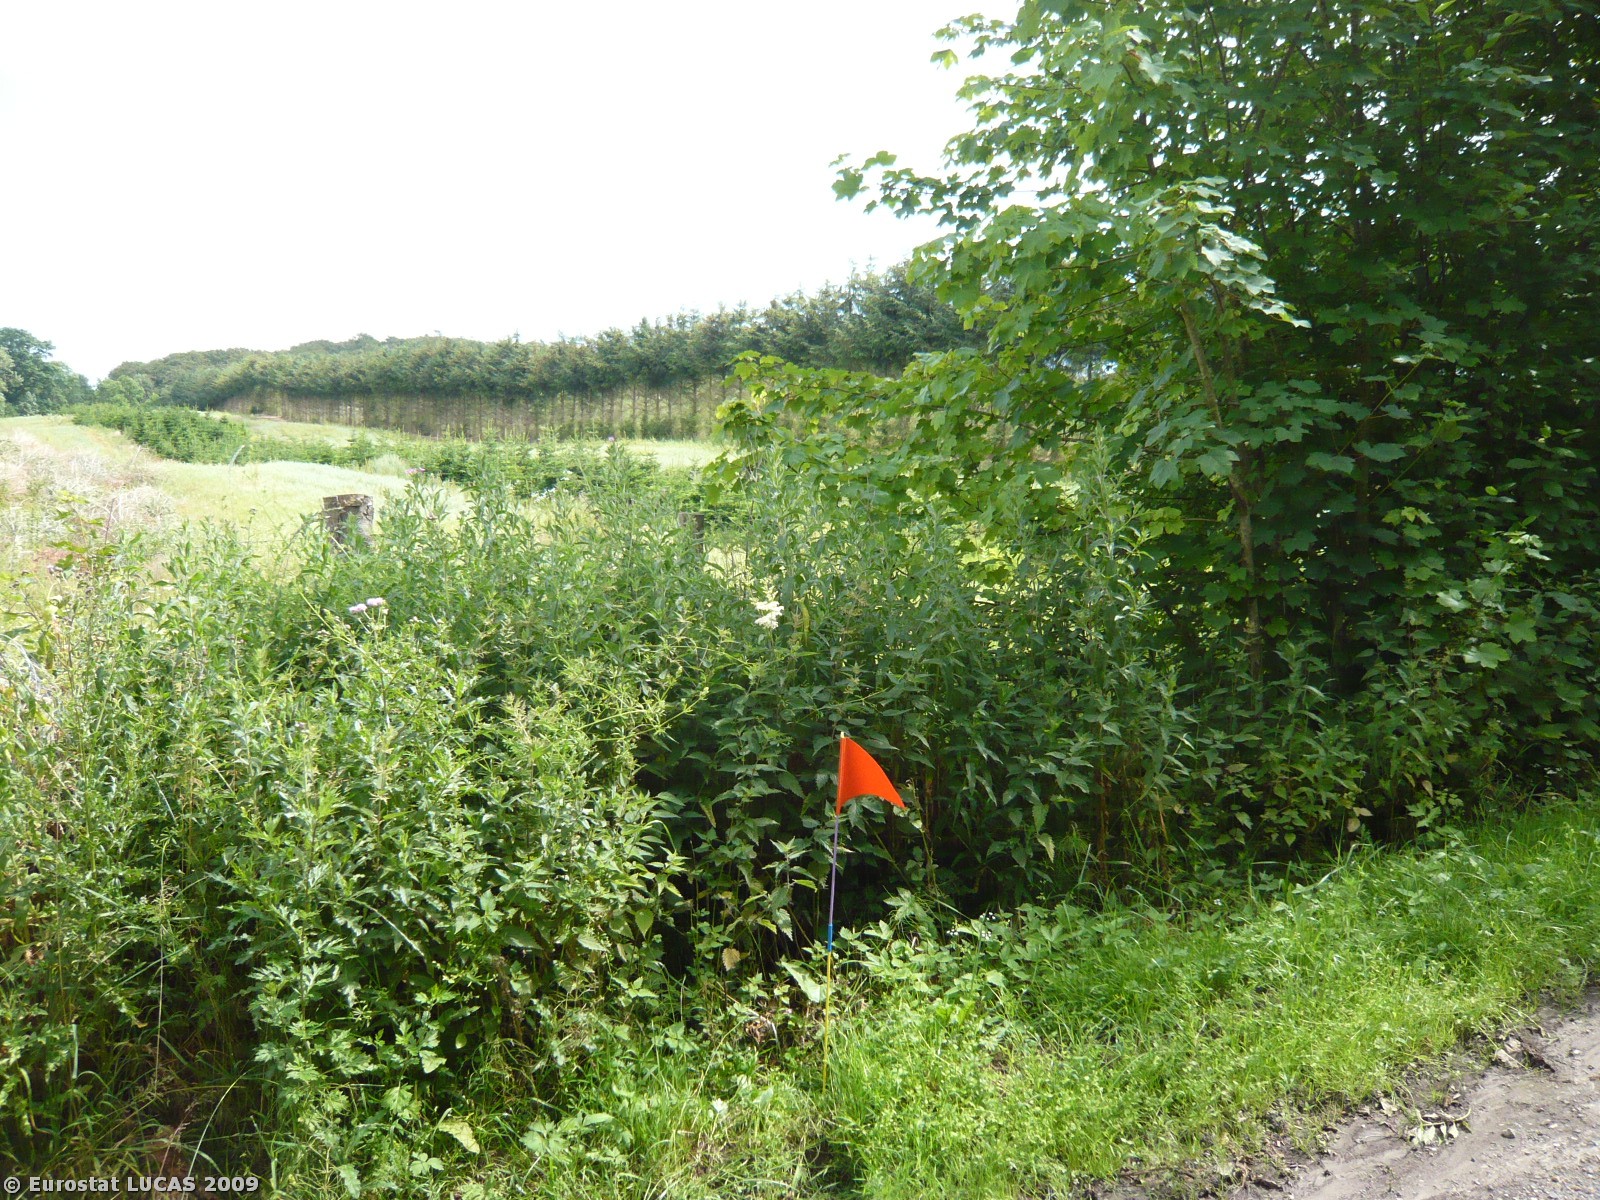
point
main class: Grassland
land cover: Grassland without tree/shrub cover
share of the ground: > 75 %
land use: Forestry
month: July
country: DK
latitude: 55.4327
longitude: 10.1737
